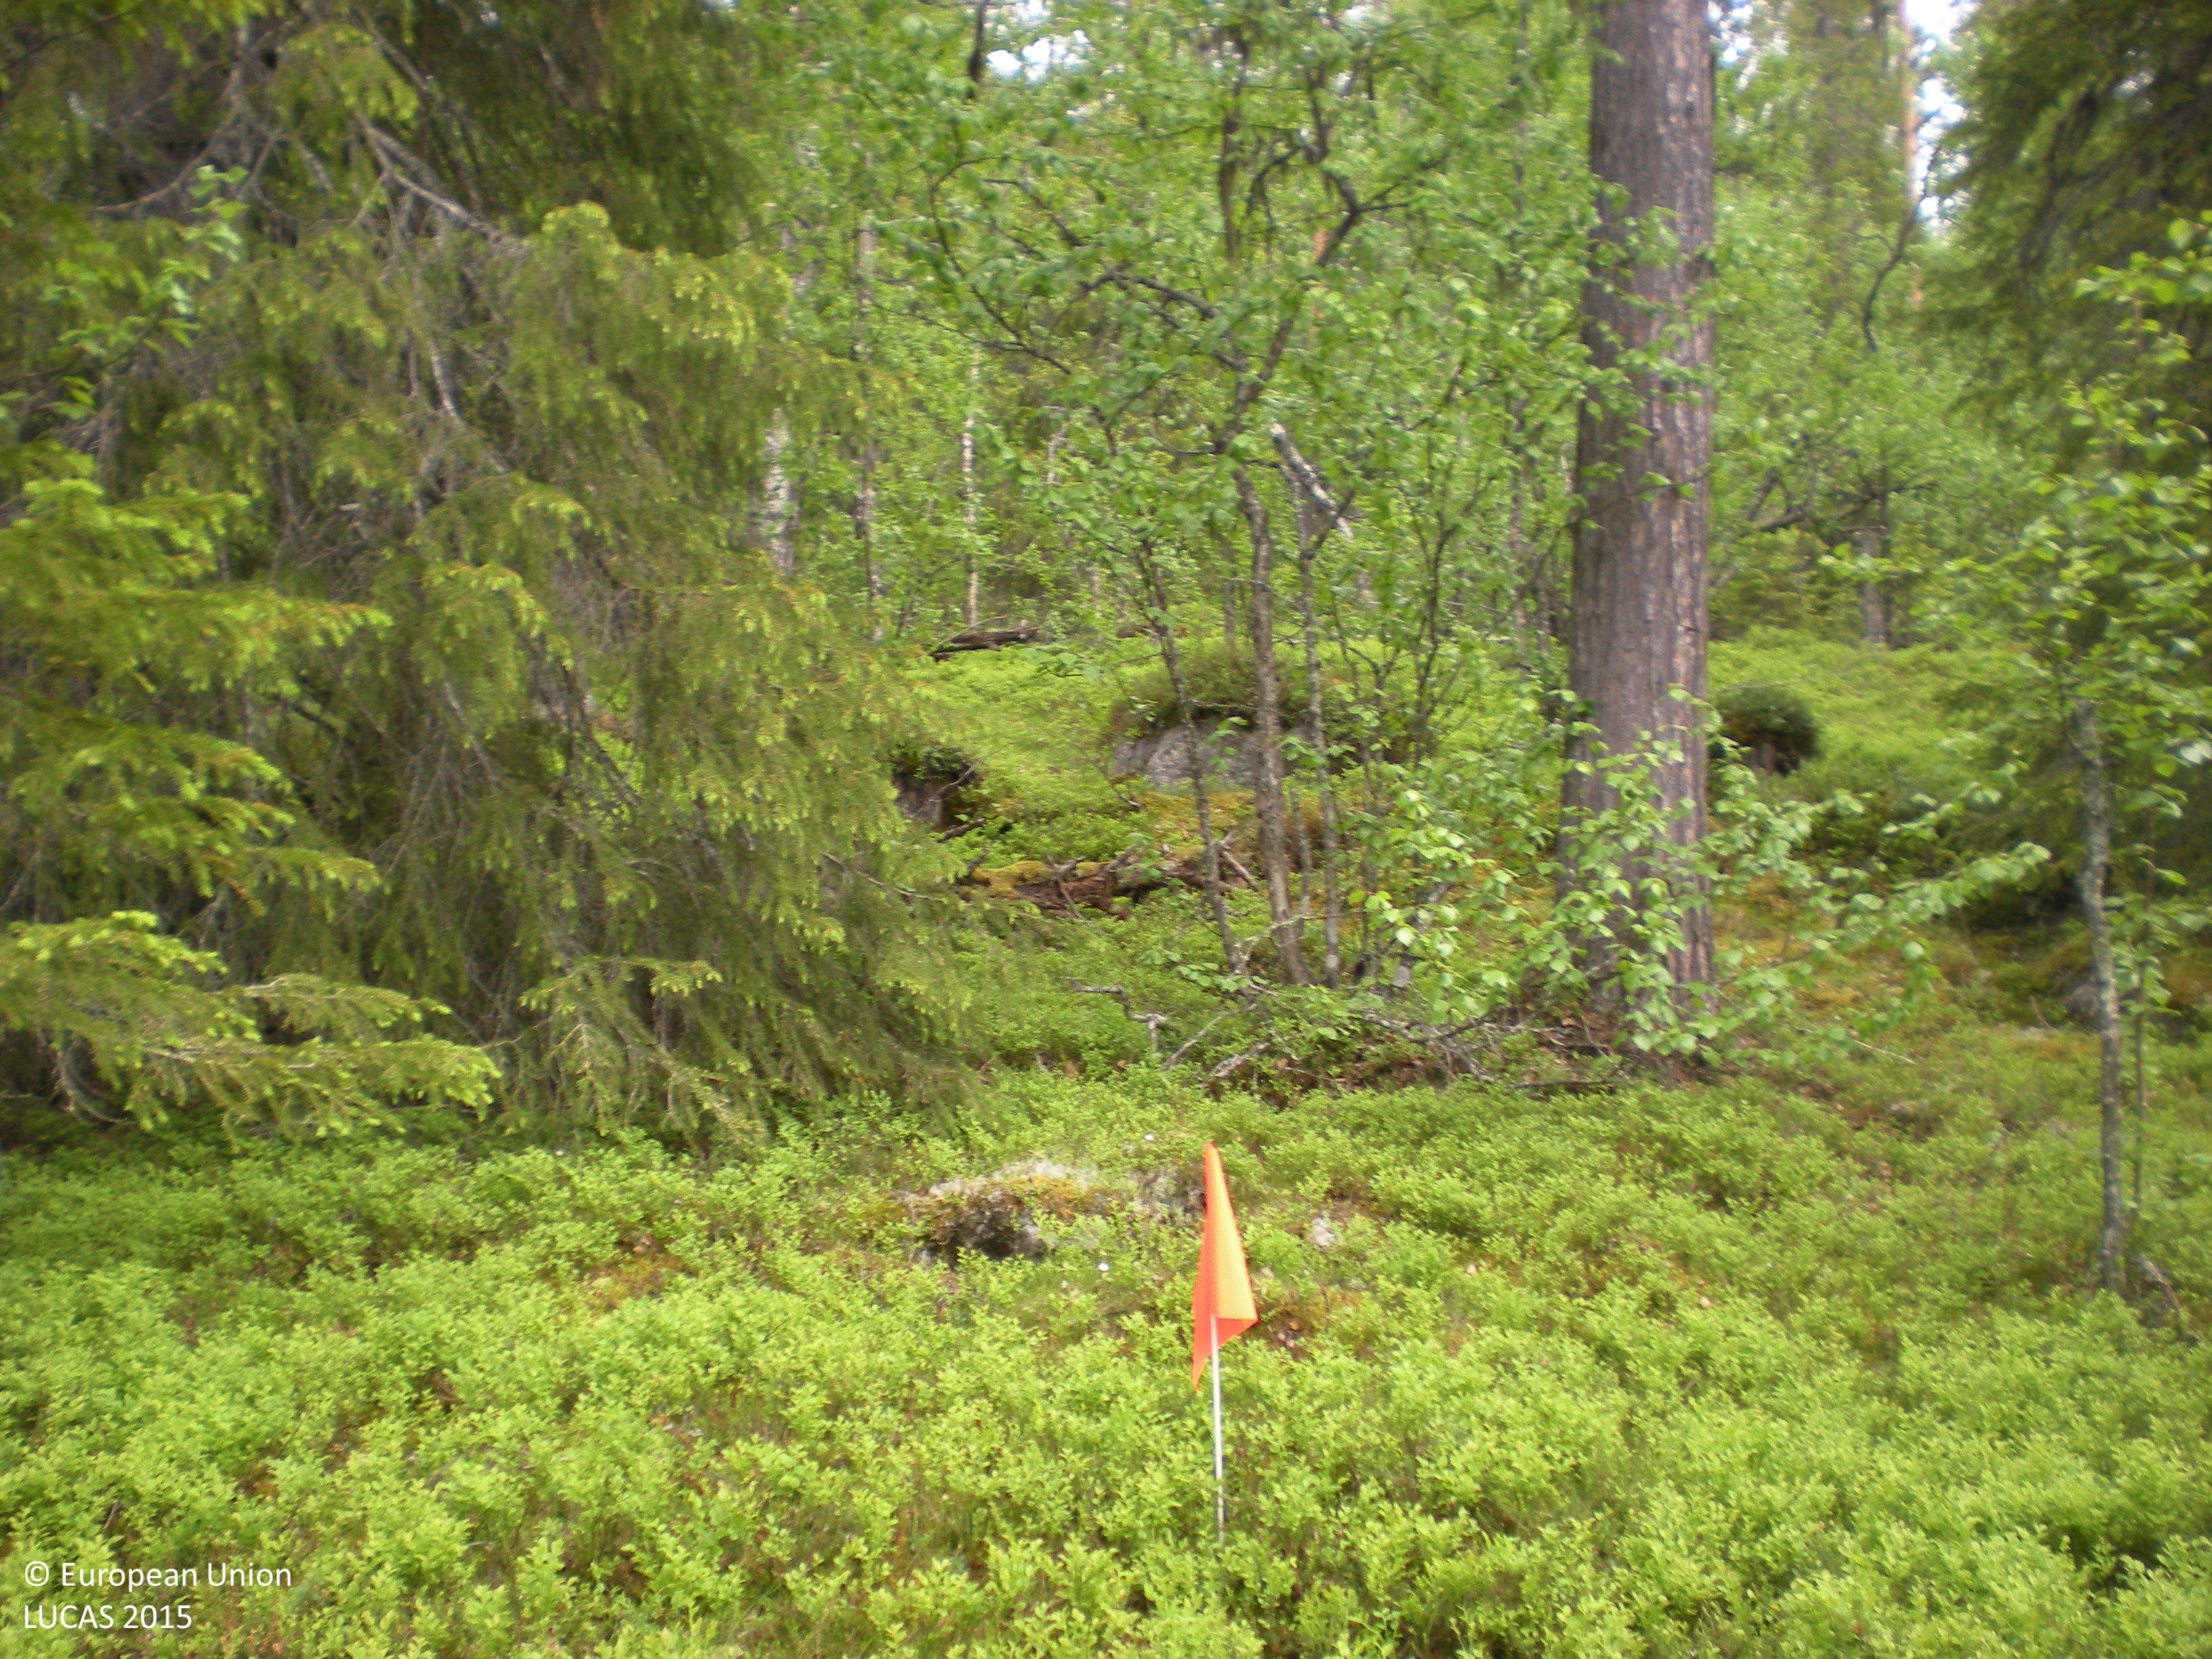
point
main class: Woodland
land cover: Other mixed woodland
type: boreal forest
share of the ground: 50 - 75 %
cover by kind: coniferous forest trees 50 %, broadleaved forest trees 20 %, shrubs 20 %, lichens and mosses 10 %
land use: Forestry
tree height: > 5 m
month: July
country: SE
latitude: 66.1611
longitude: 17.1615
